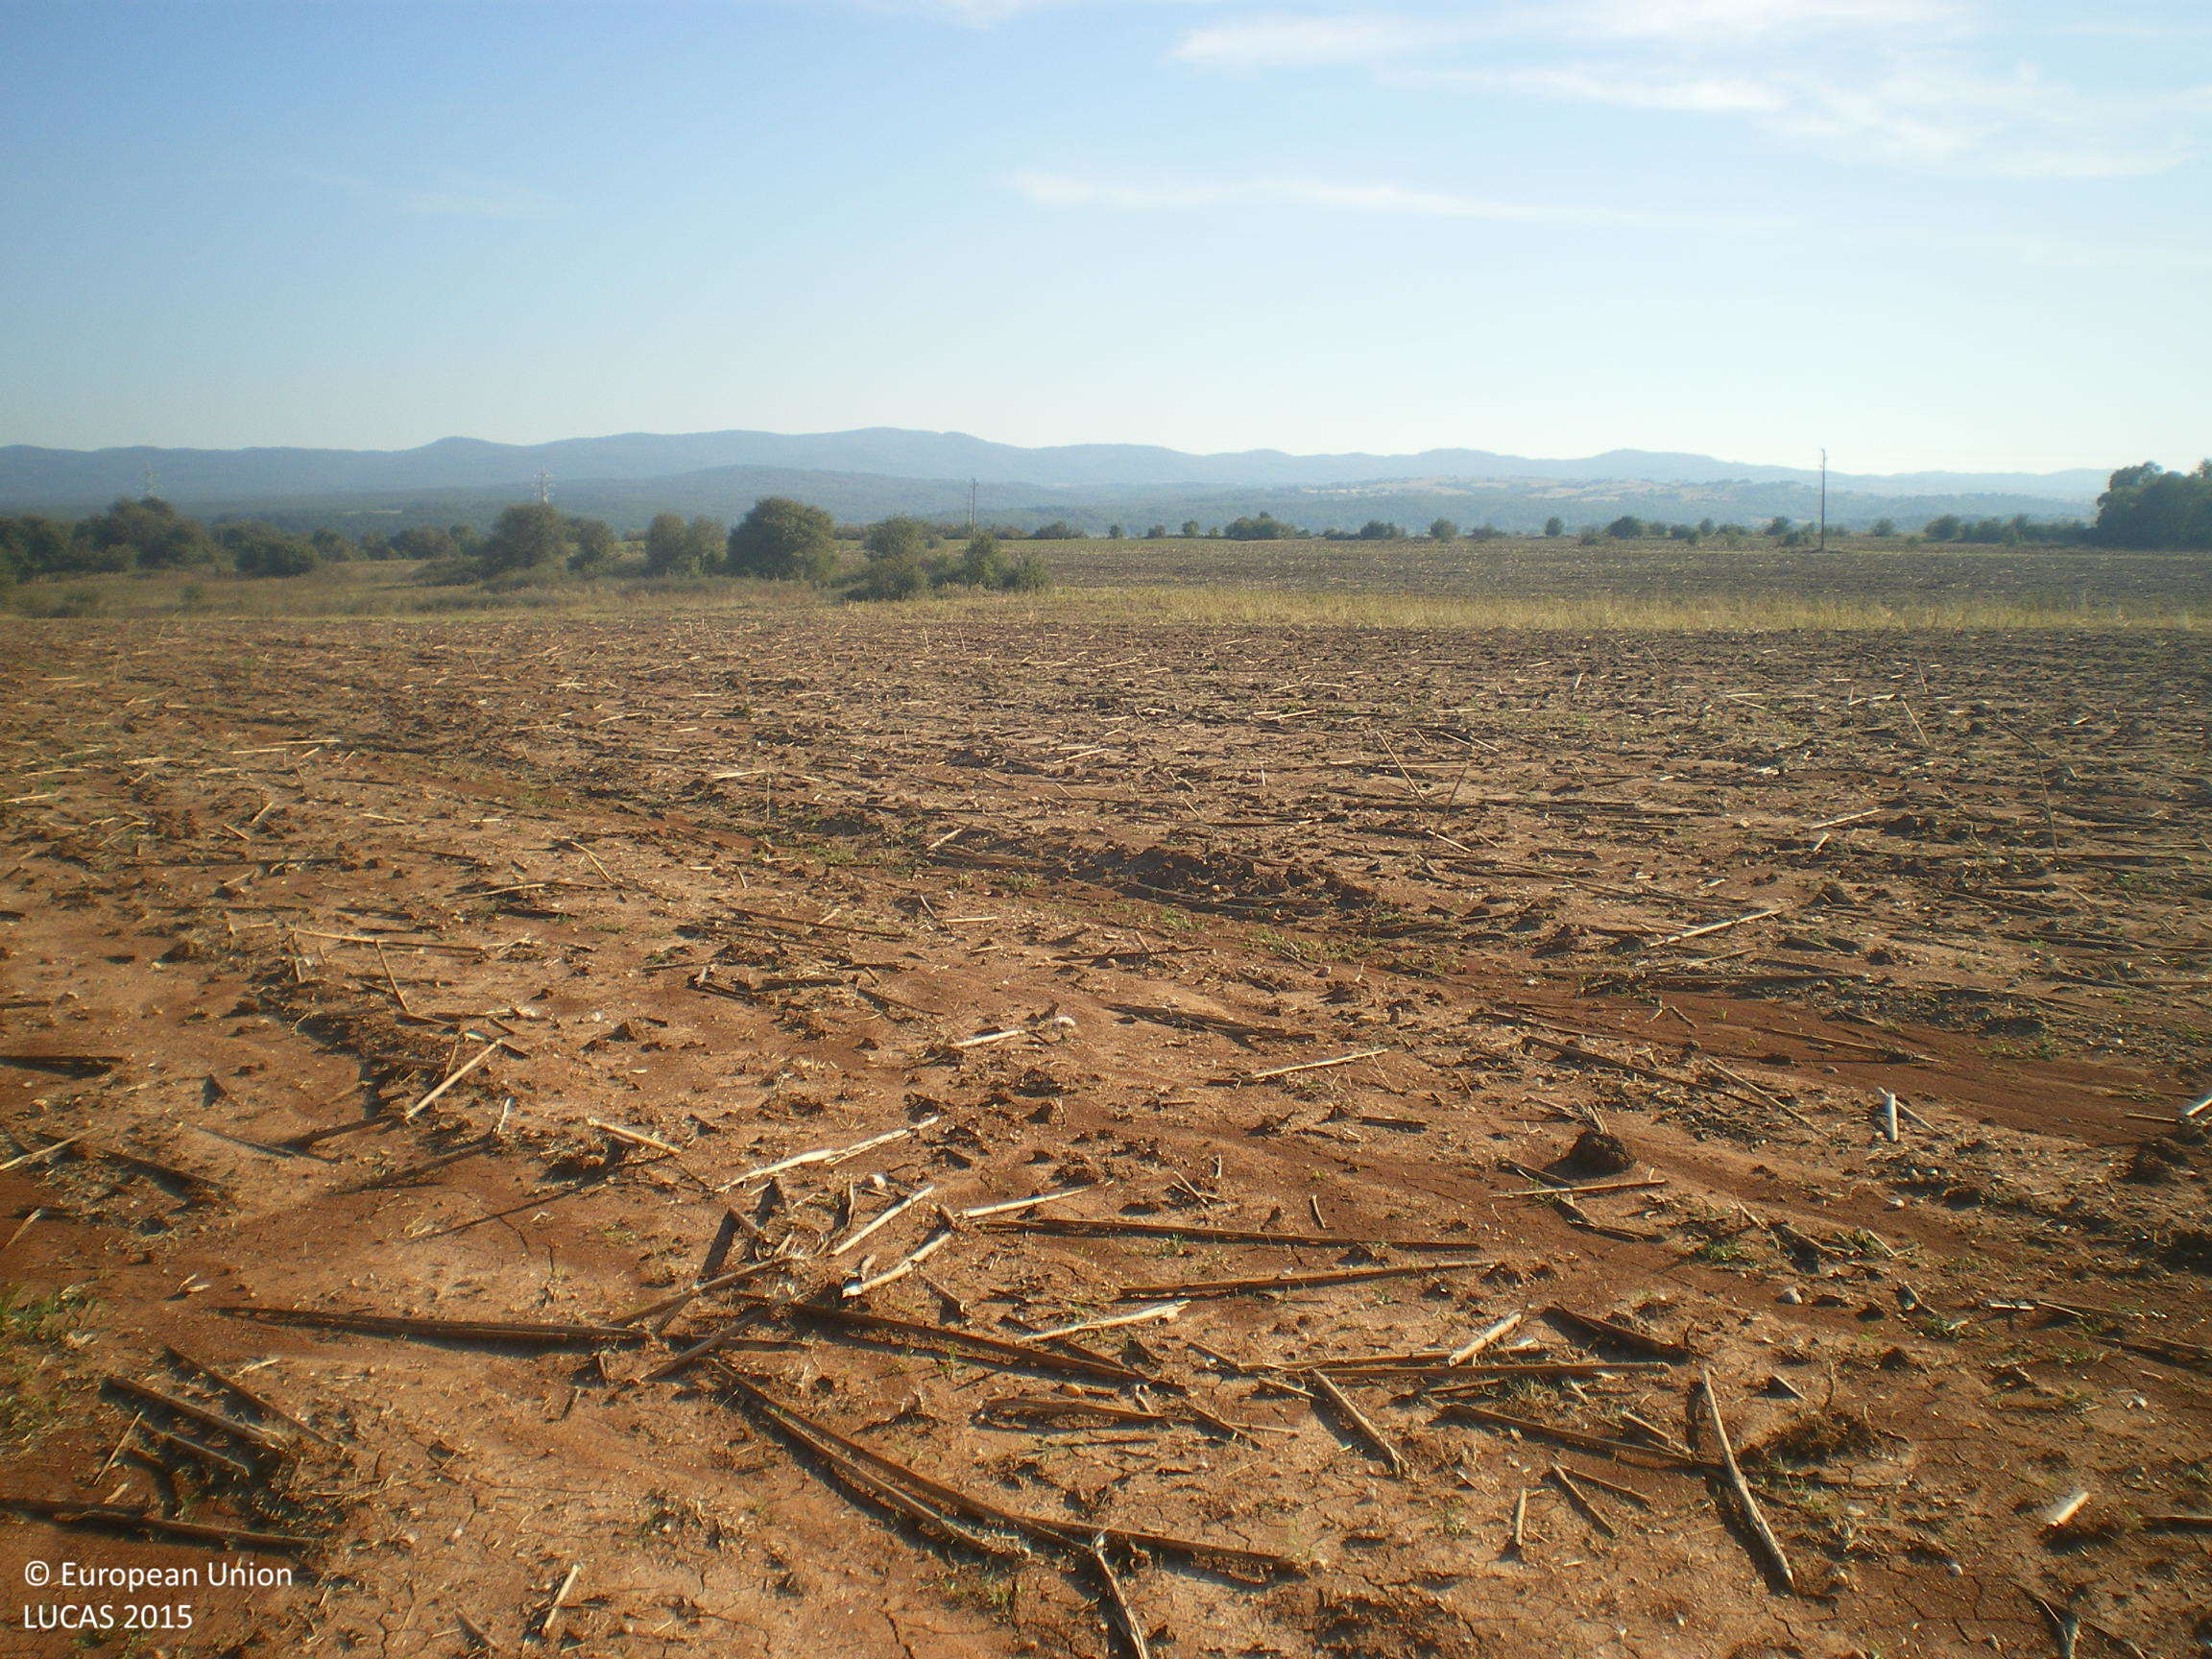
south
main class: Cropland
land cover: Sunflower
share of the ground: < 10 %
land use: Agriculture (excluding fallow land and kitchen gardens)
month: September
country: BG
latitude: 41.8265
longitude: 25.8045
